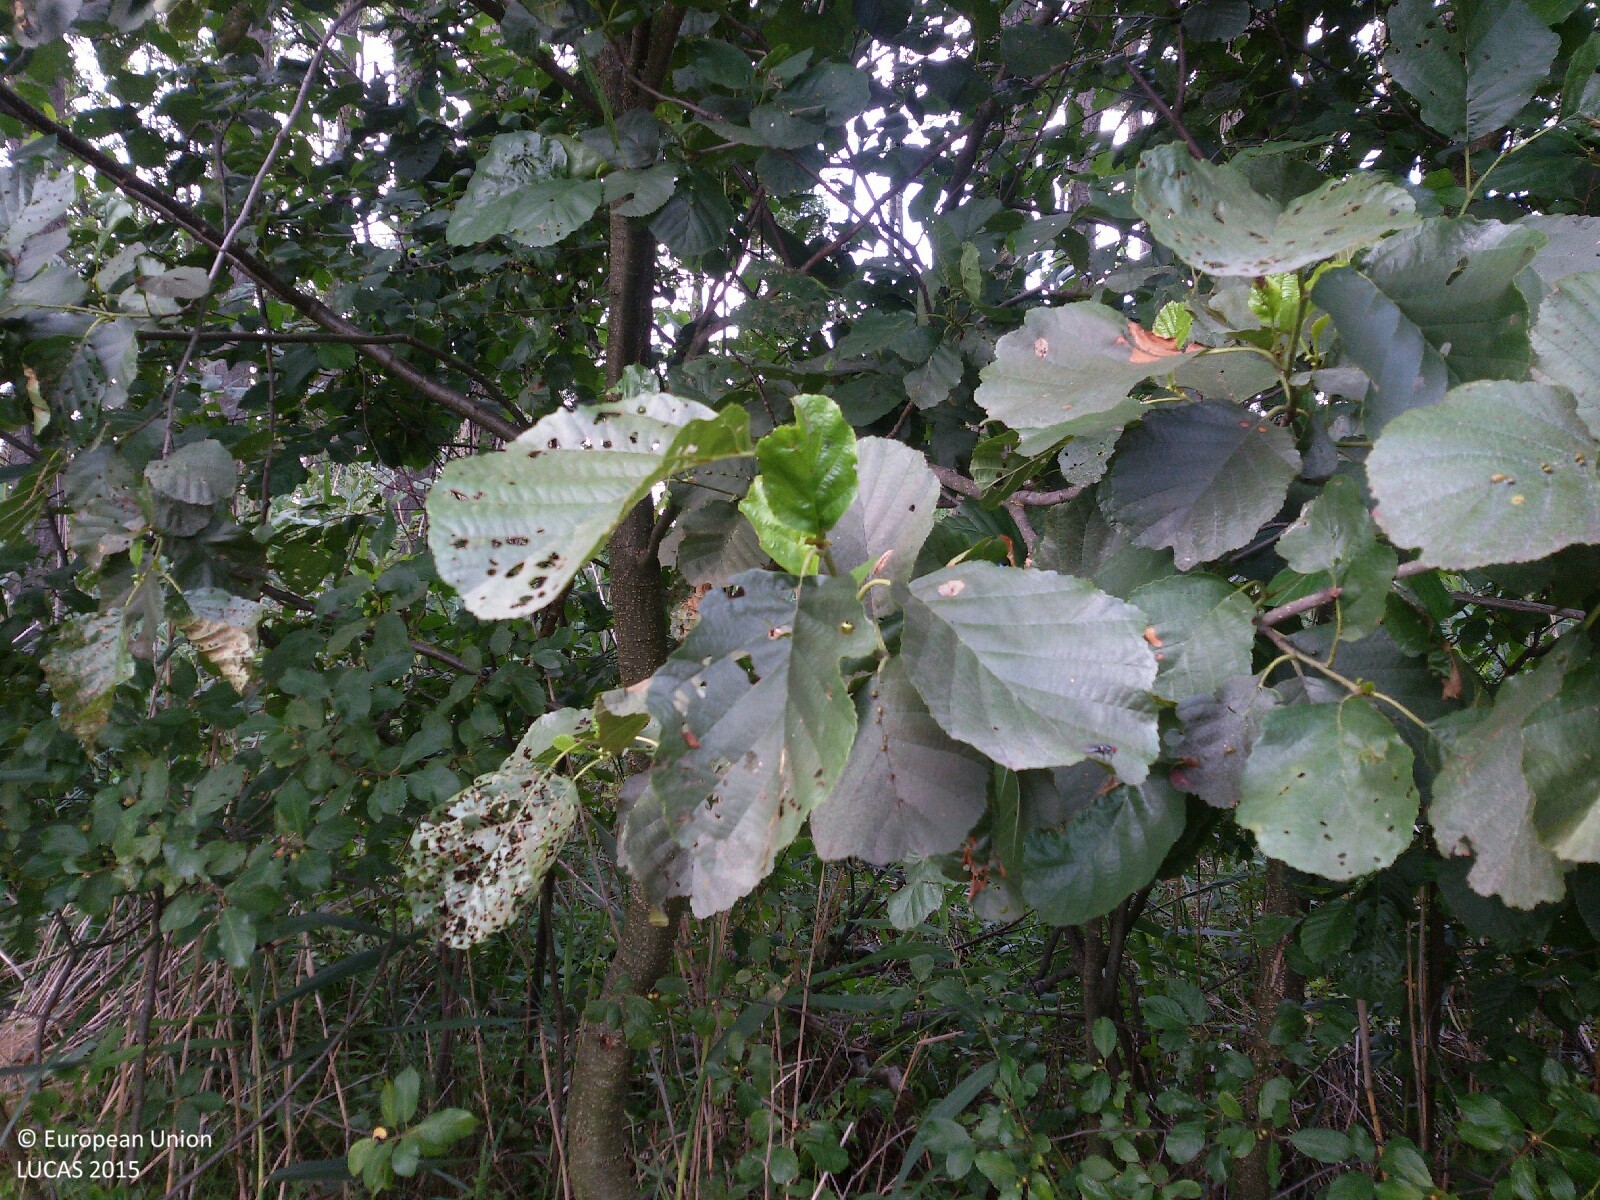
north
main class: Woodland
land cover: Broadleaved woodland
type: non-riverine alder, birch or aspen forest
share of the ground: > 75 %
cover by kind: broadleaved forest trees 95 %, shrubs 5 %
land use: Forestry
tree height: > 5 m
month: July
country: PL
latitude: 52.5144
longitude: 21.2315
